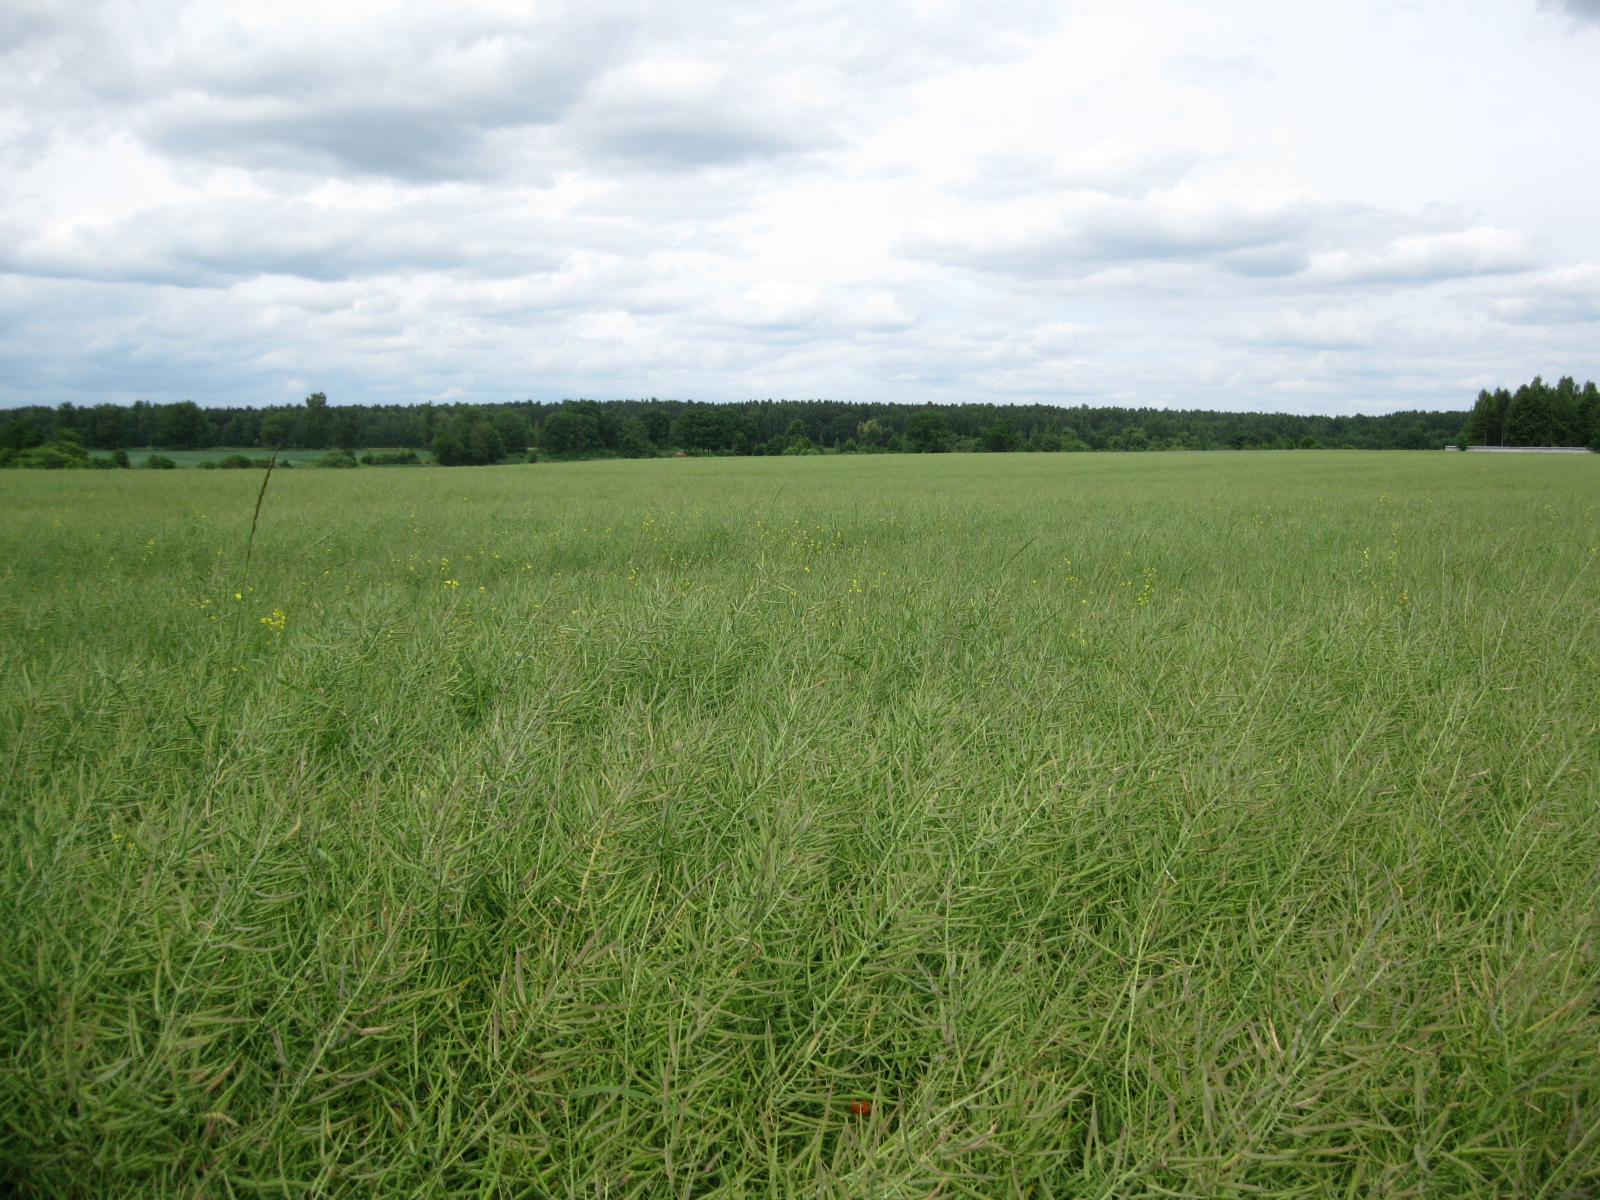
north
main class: Cropland
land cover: Rape and turnip rape
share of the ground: > 75 %
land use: Agriculture (excluding fallow land and kitchen gardens)
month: June
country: LT
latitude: 55.6076
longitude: 24.2377
